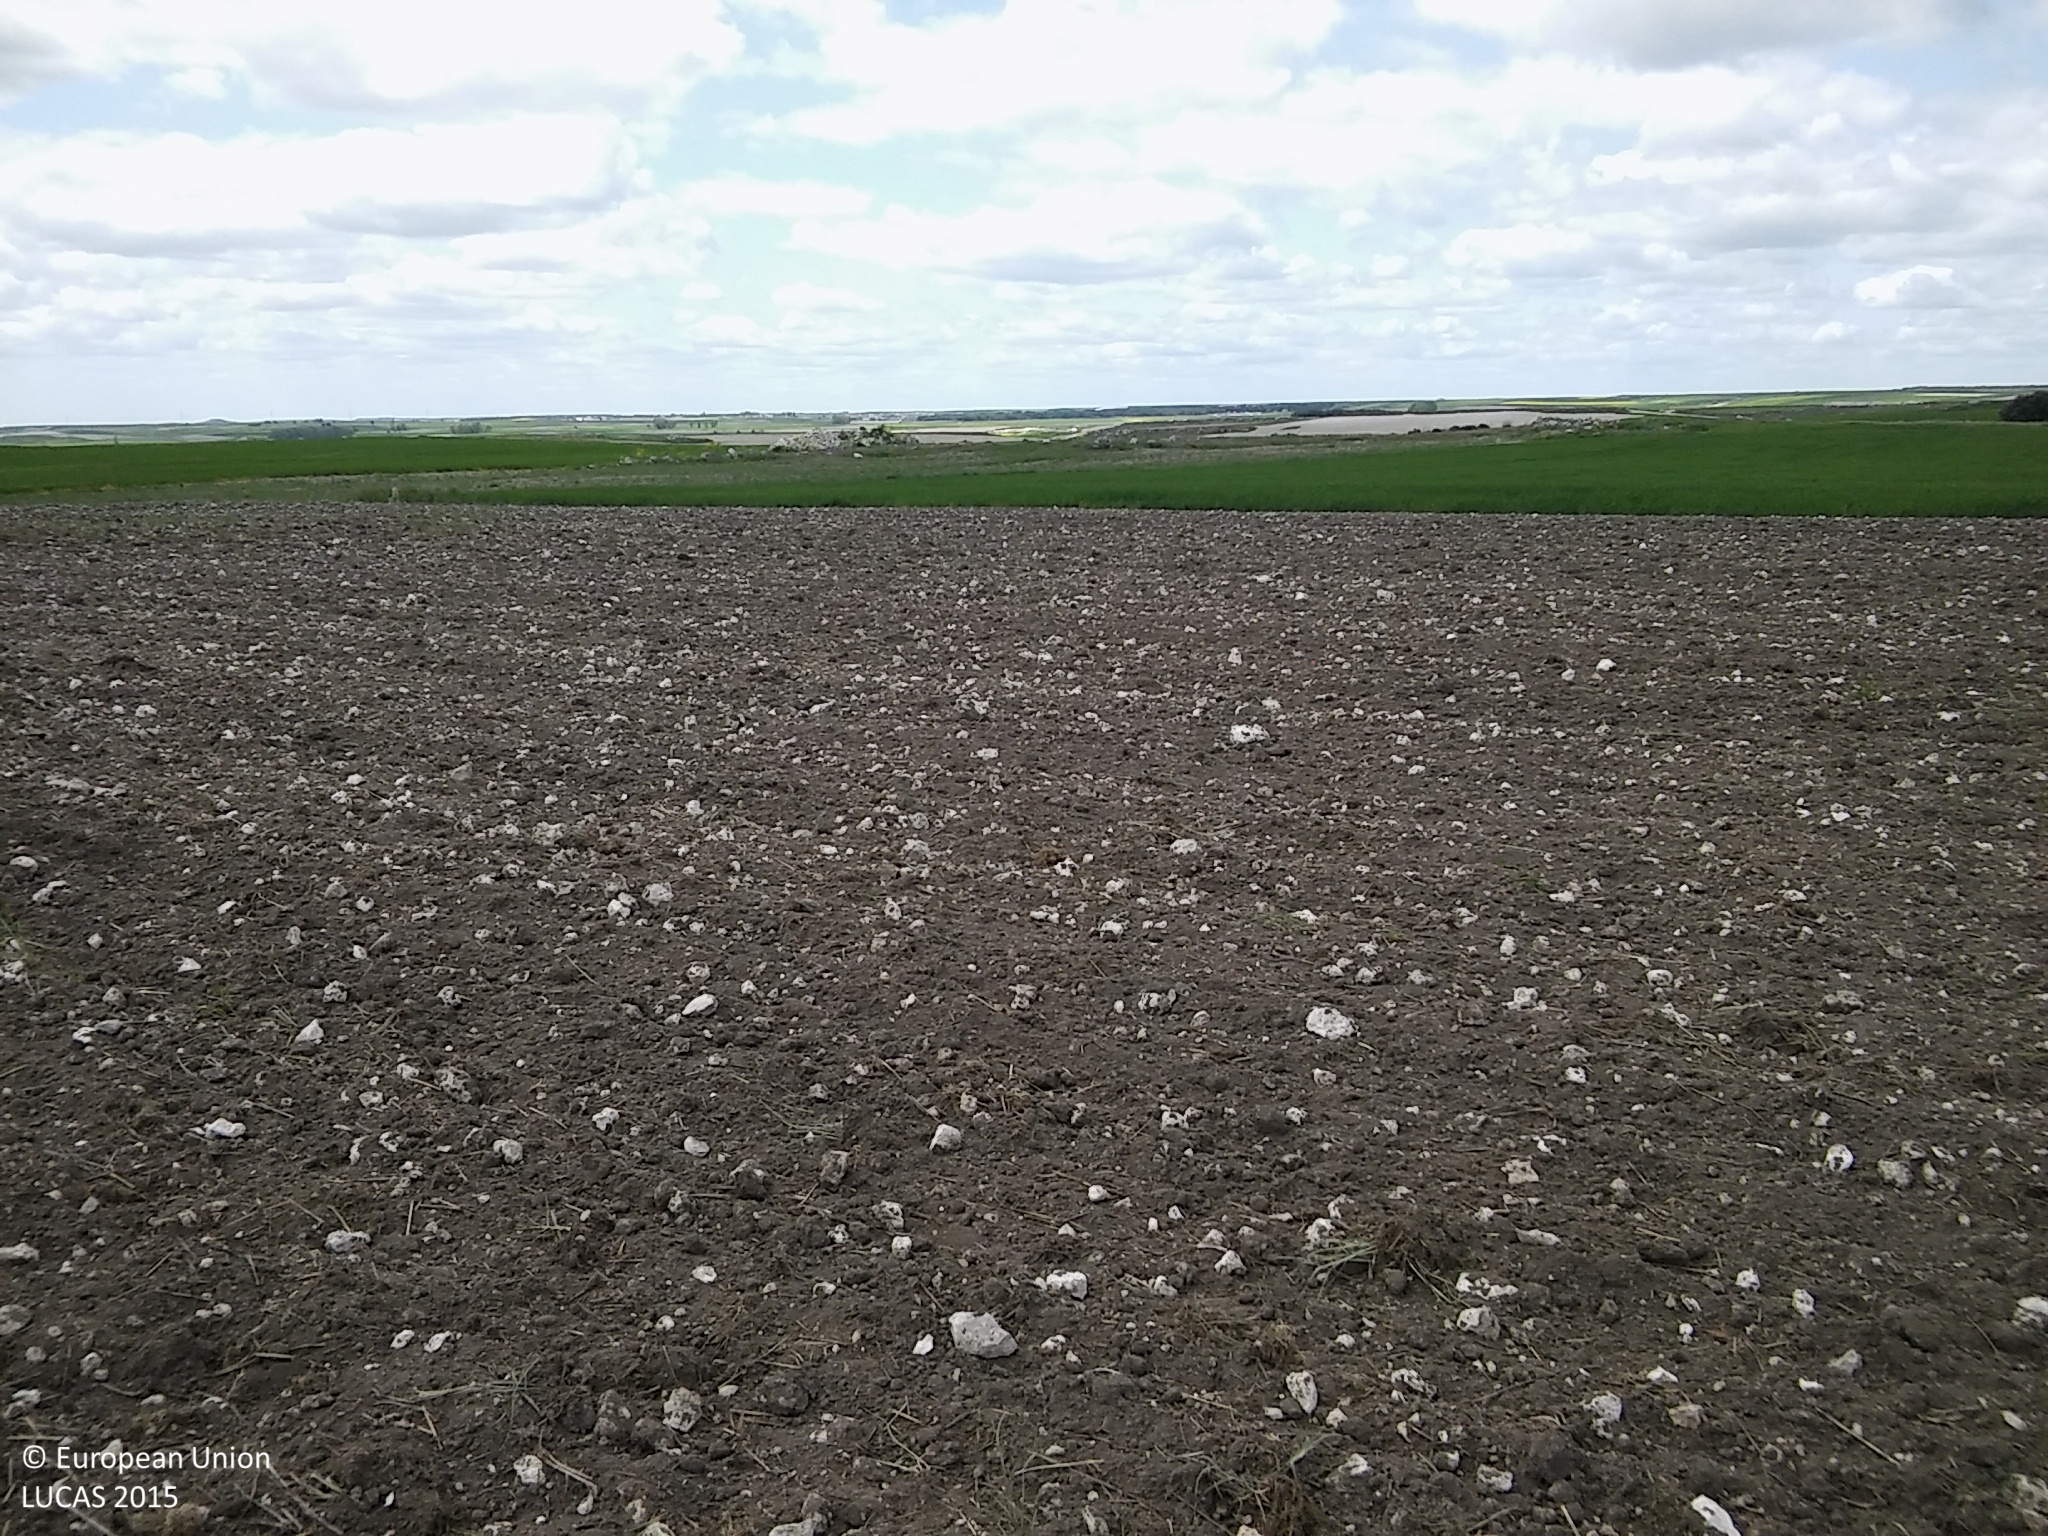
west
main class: Cropland
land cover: Sunflower
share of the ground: < 10 %
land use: Agriculture (excluding fallow land and kitchen gardens)
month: May
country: ES
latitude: 41.4075
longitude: -4.0876
